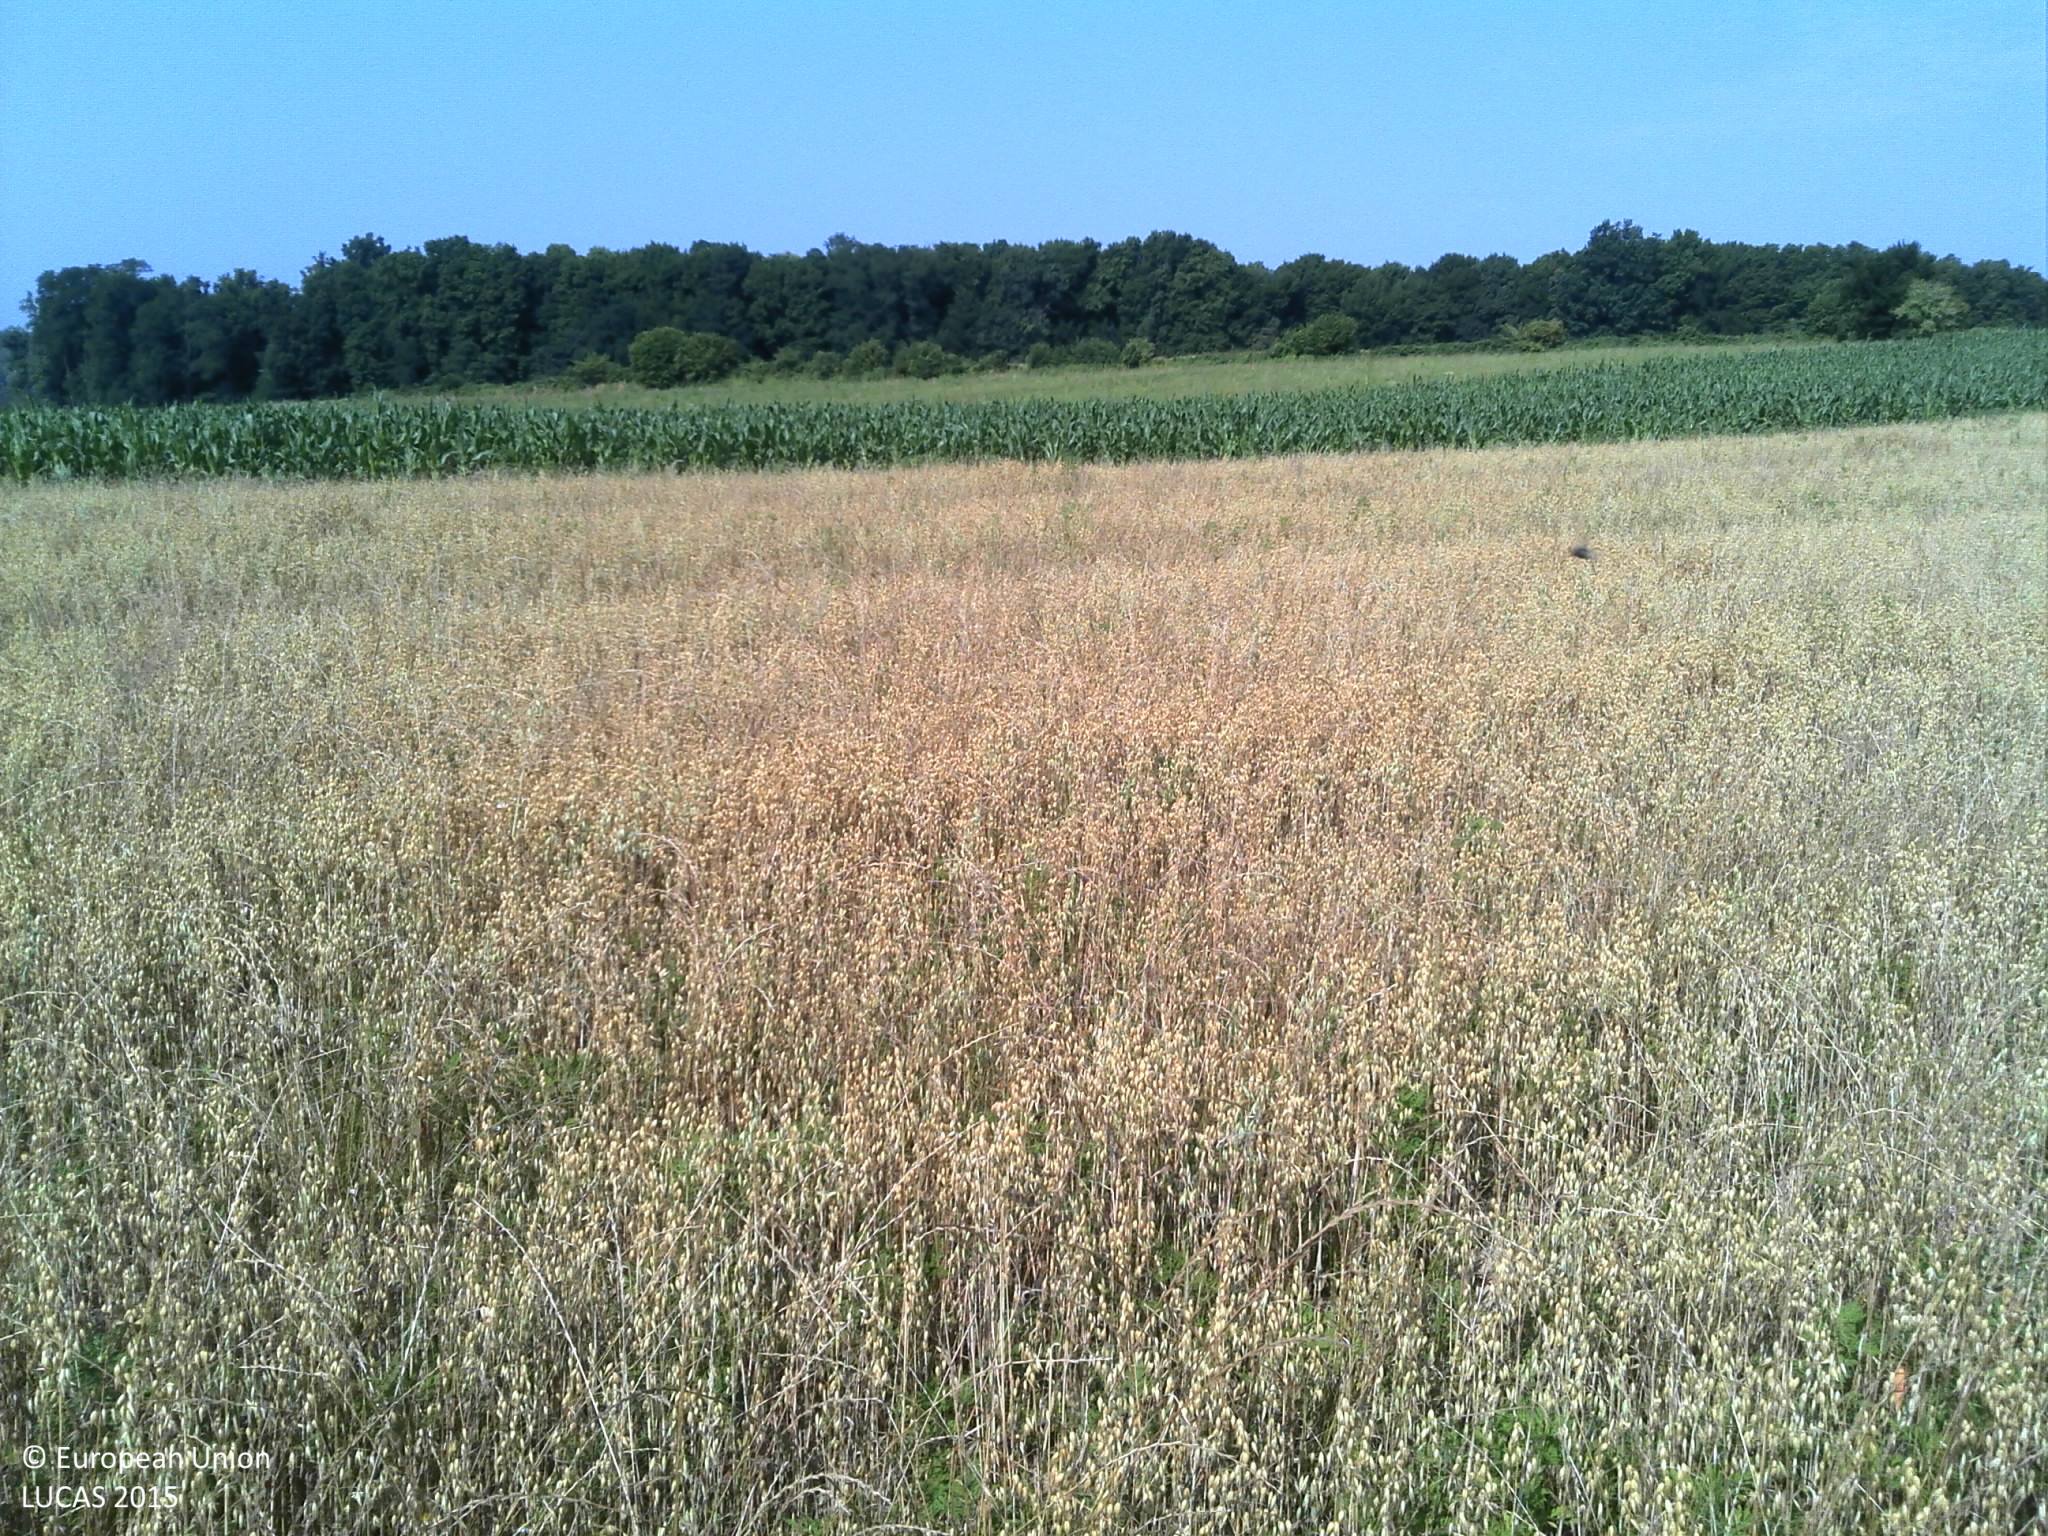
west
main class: Cropland
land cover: Oats
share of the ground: > 75 %
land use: Agriculture (excluding fallow land and kitchen gardens)
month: July
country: HR
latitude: 45.7712
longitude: 16.5447
